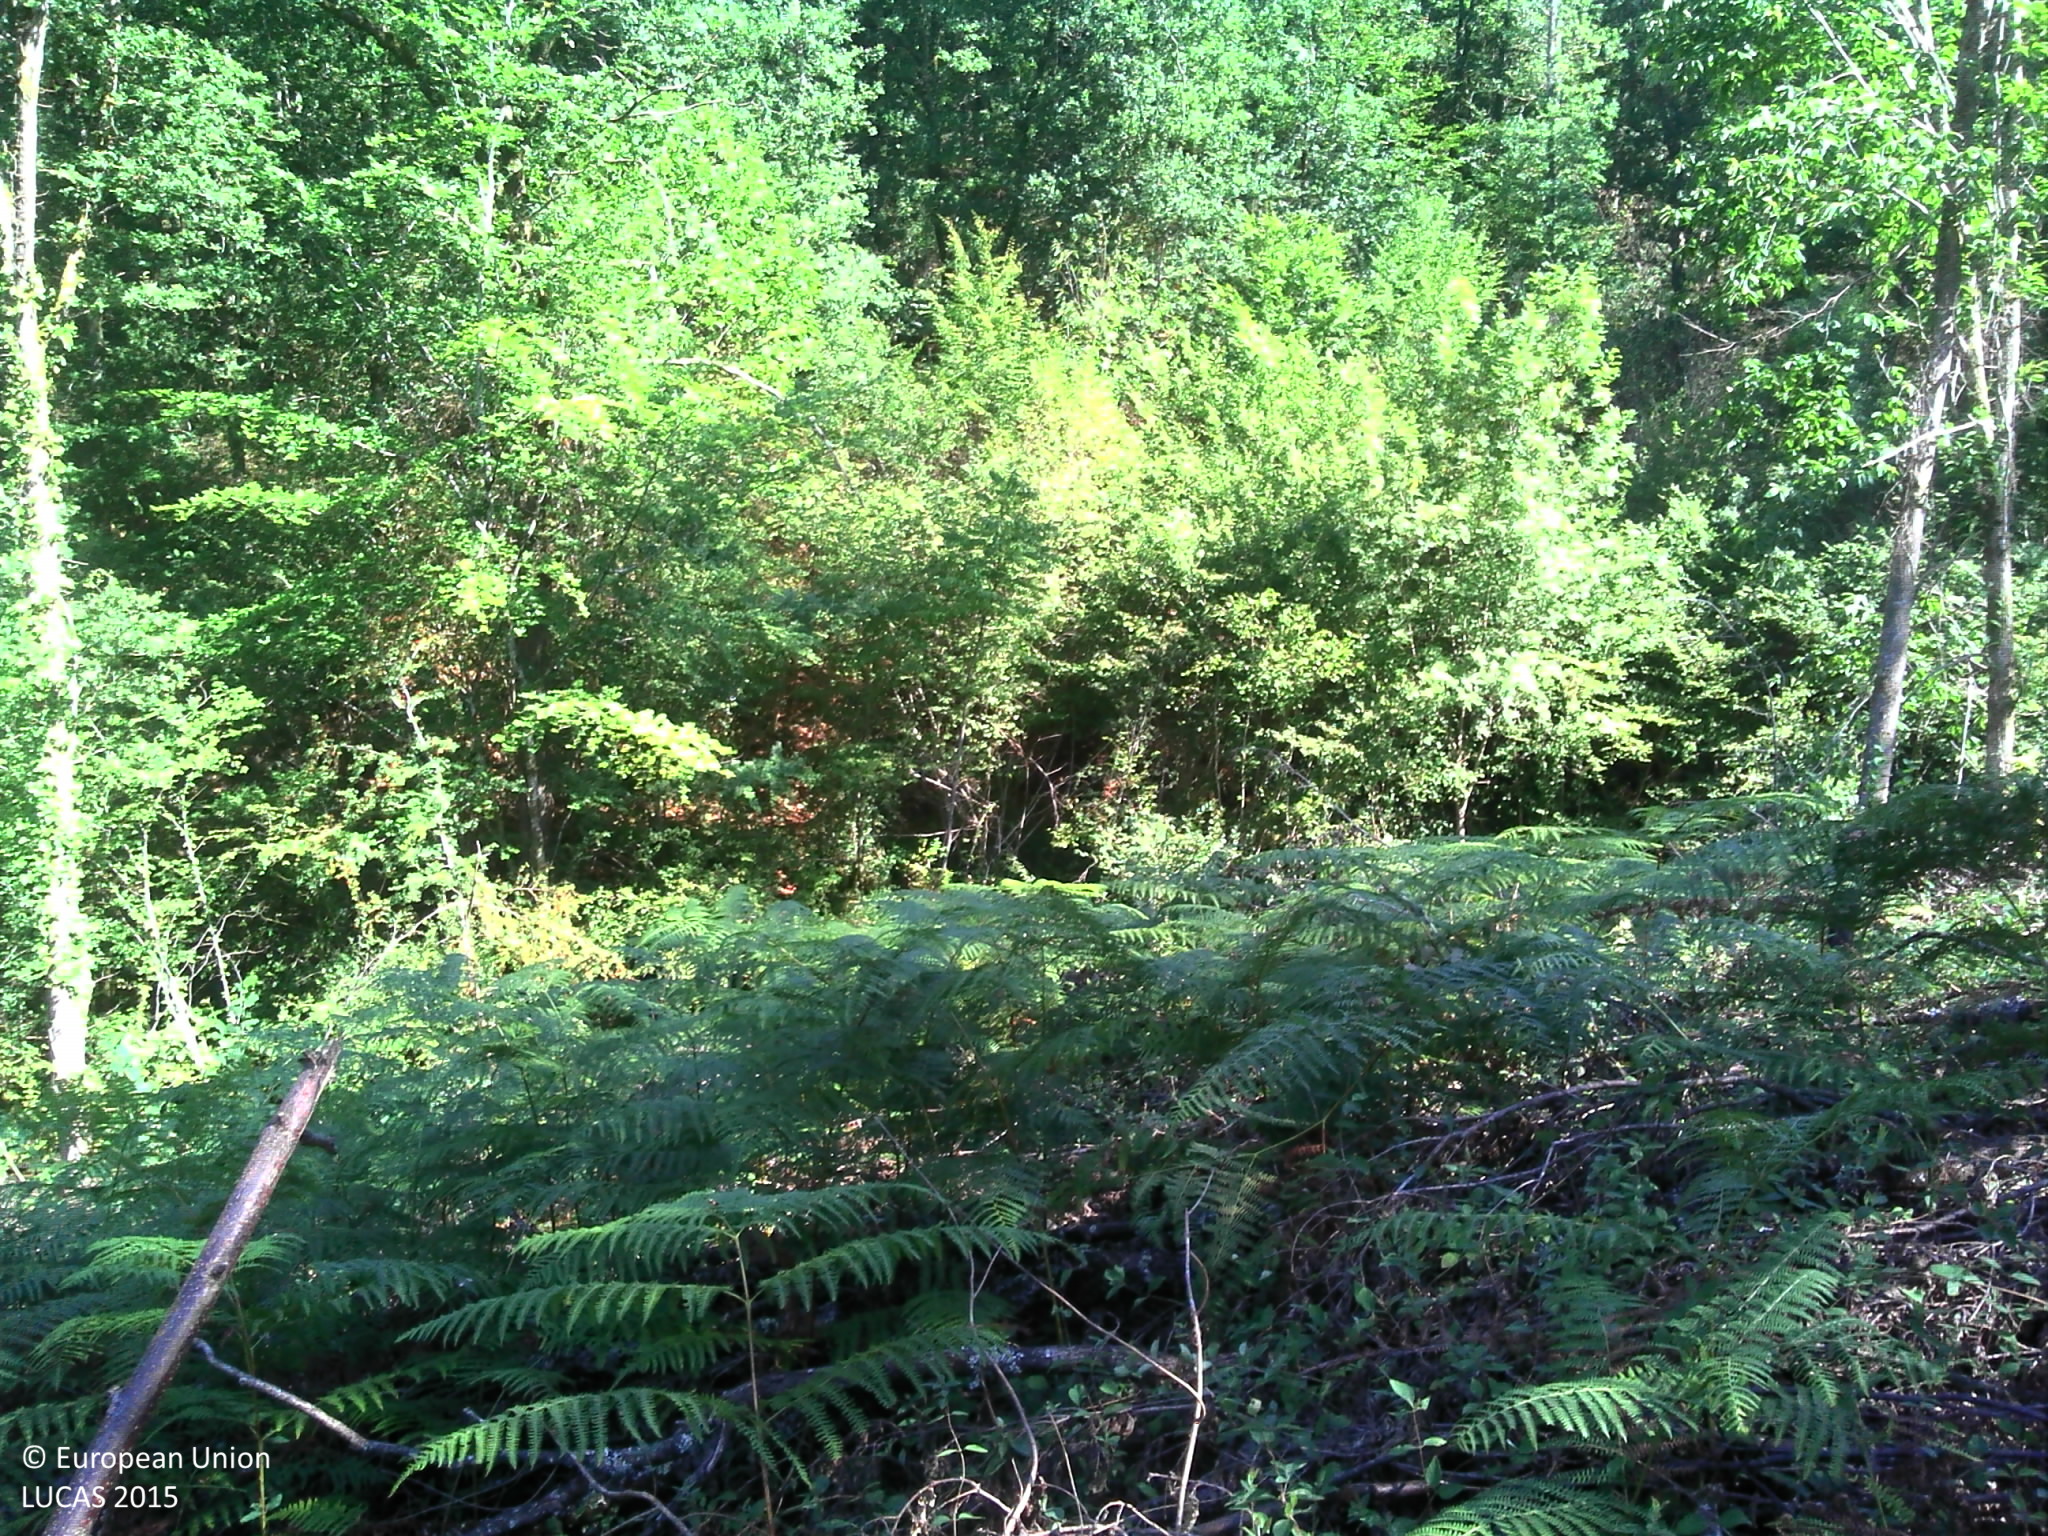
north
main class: Grassland
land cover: Spontaneously vegetated surfaces
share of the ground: > 75 %
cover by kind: herbaceous plants 95 %, shrubs 5 %
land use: Forestry
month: August
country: FR
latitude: 45.8795
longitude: 1.4234
